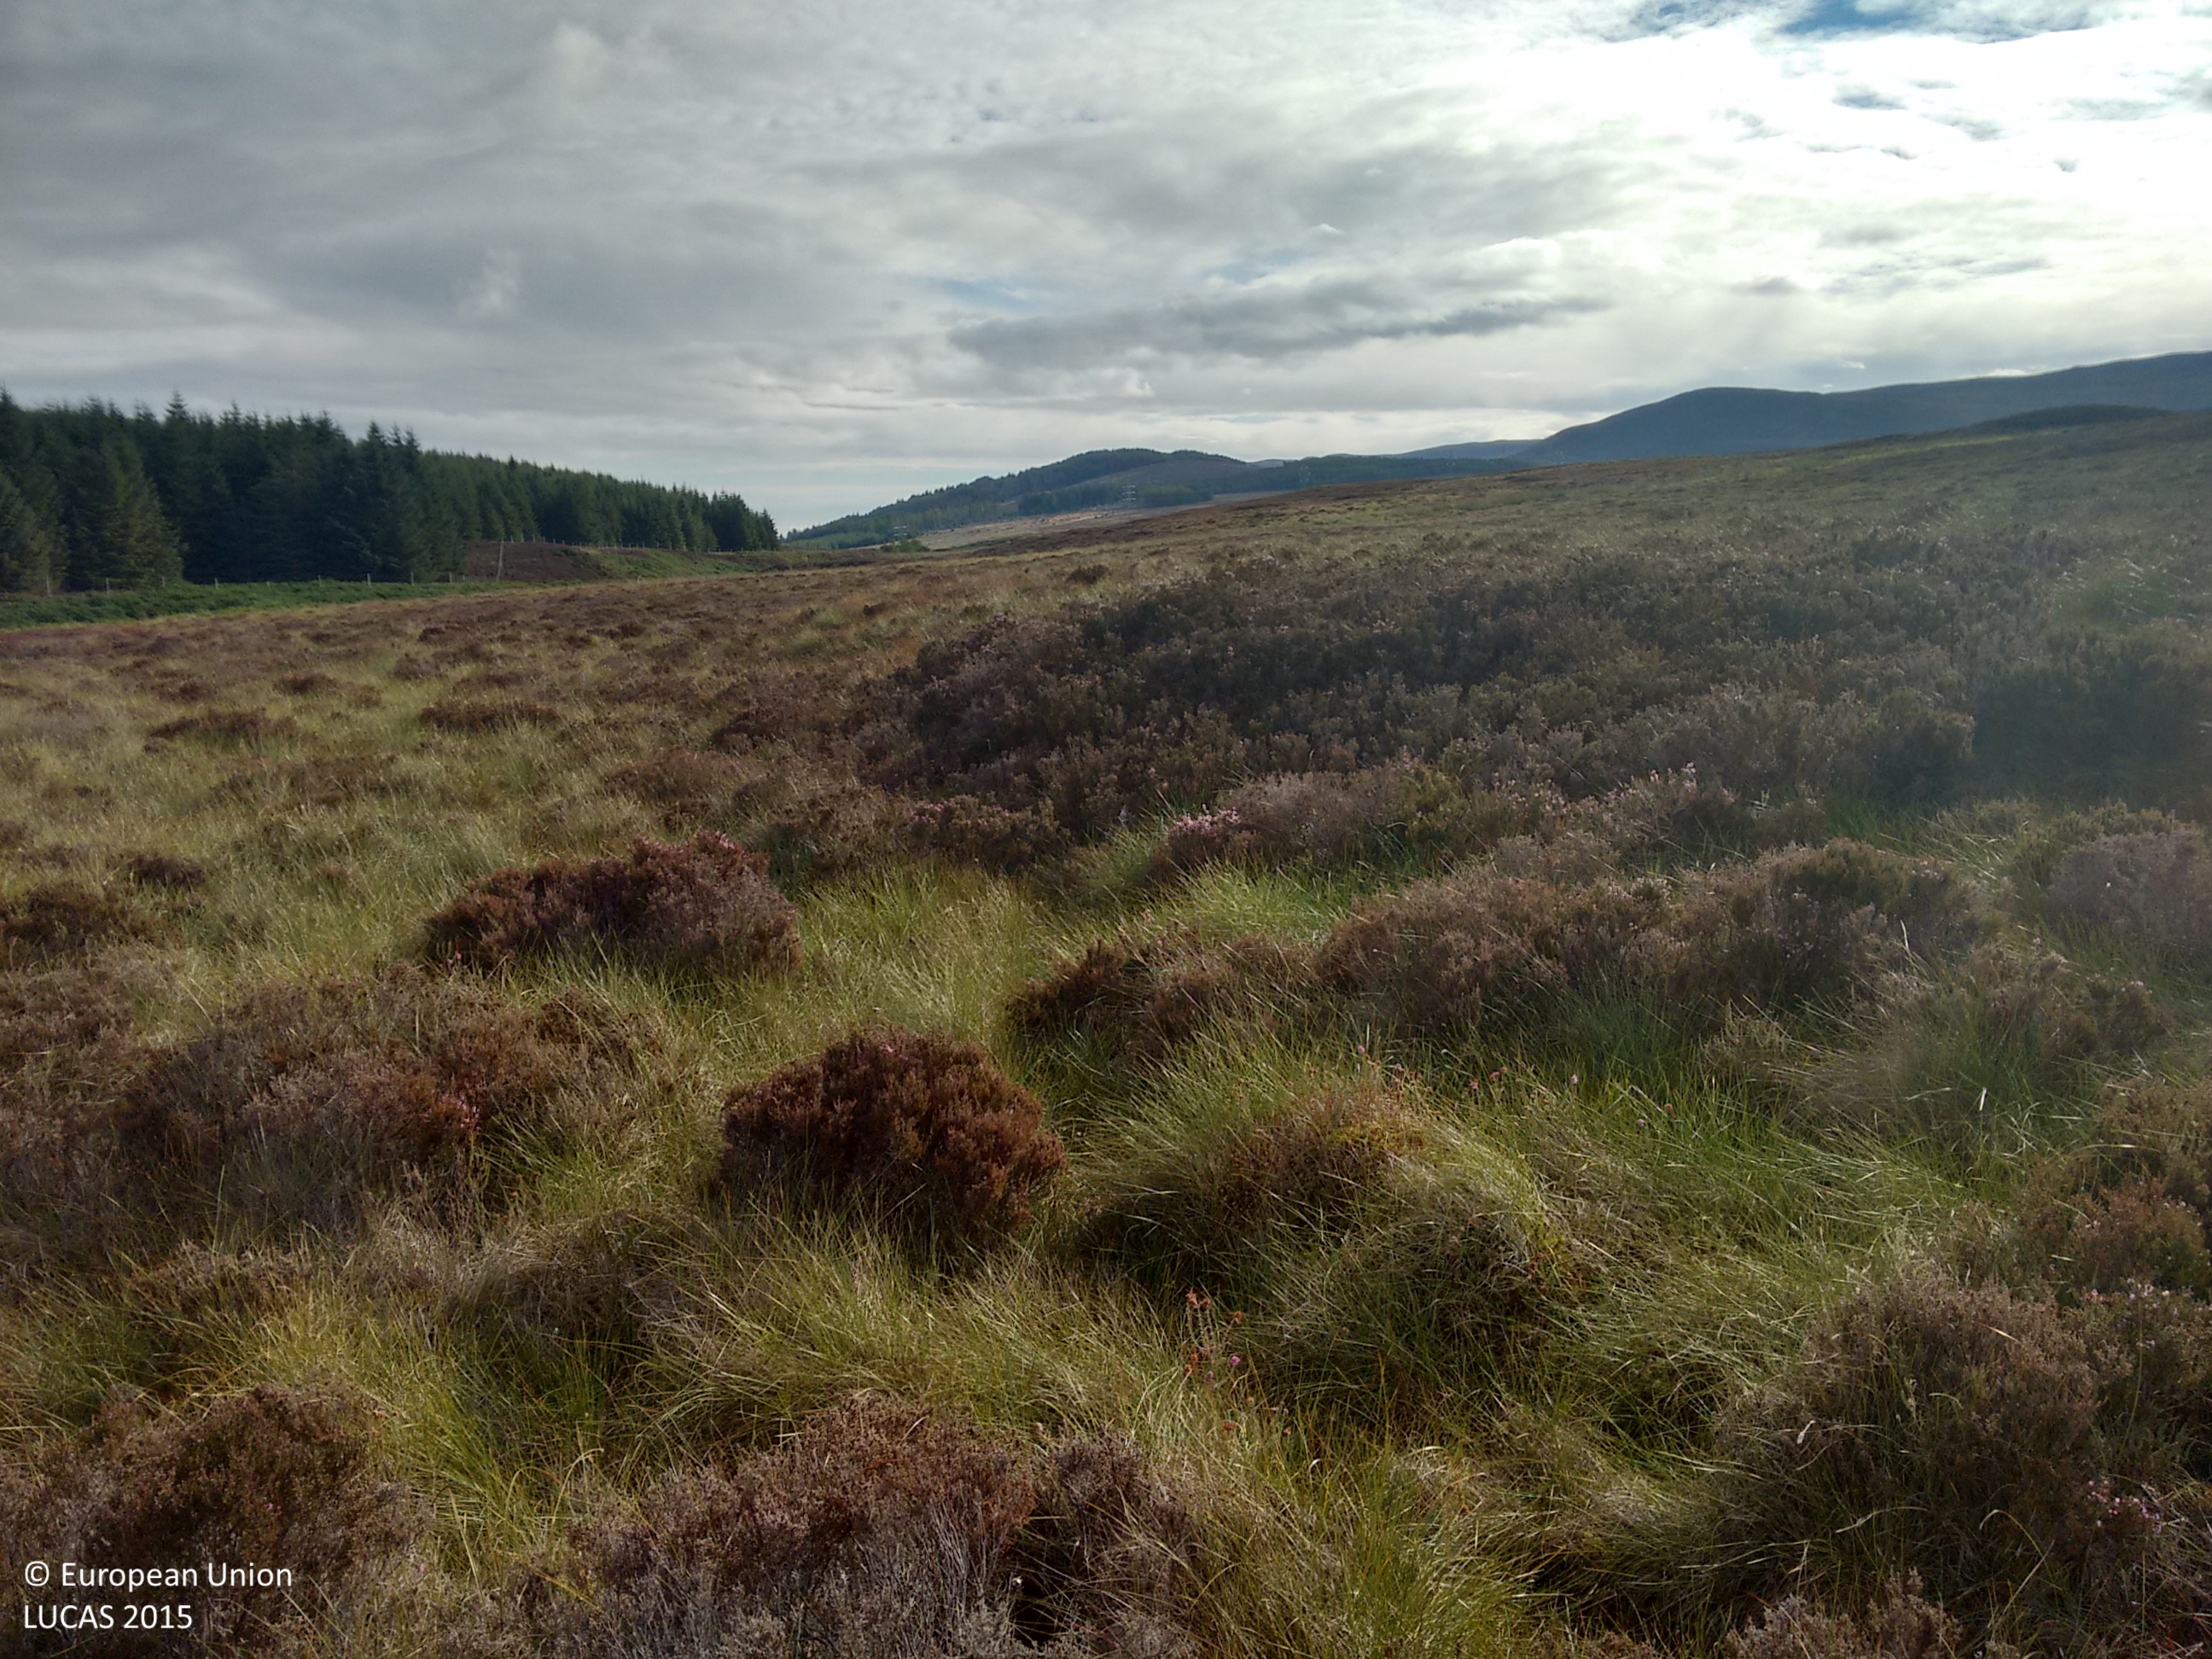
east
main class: Shrubland
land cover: Shrubland without tree cover
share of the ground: > 75 %
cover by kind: shrubs 75 %, herbaceous plants 20 %, lichens and mosses 5 %
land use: Semi-natural and natural areas not in use
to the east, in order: Shrubland without tree cover
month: September
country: GB
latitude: 57.8461
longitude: -4.3553
